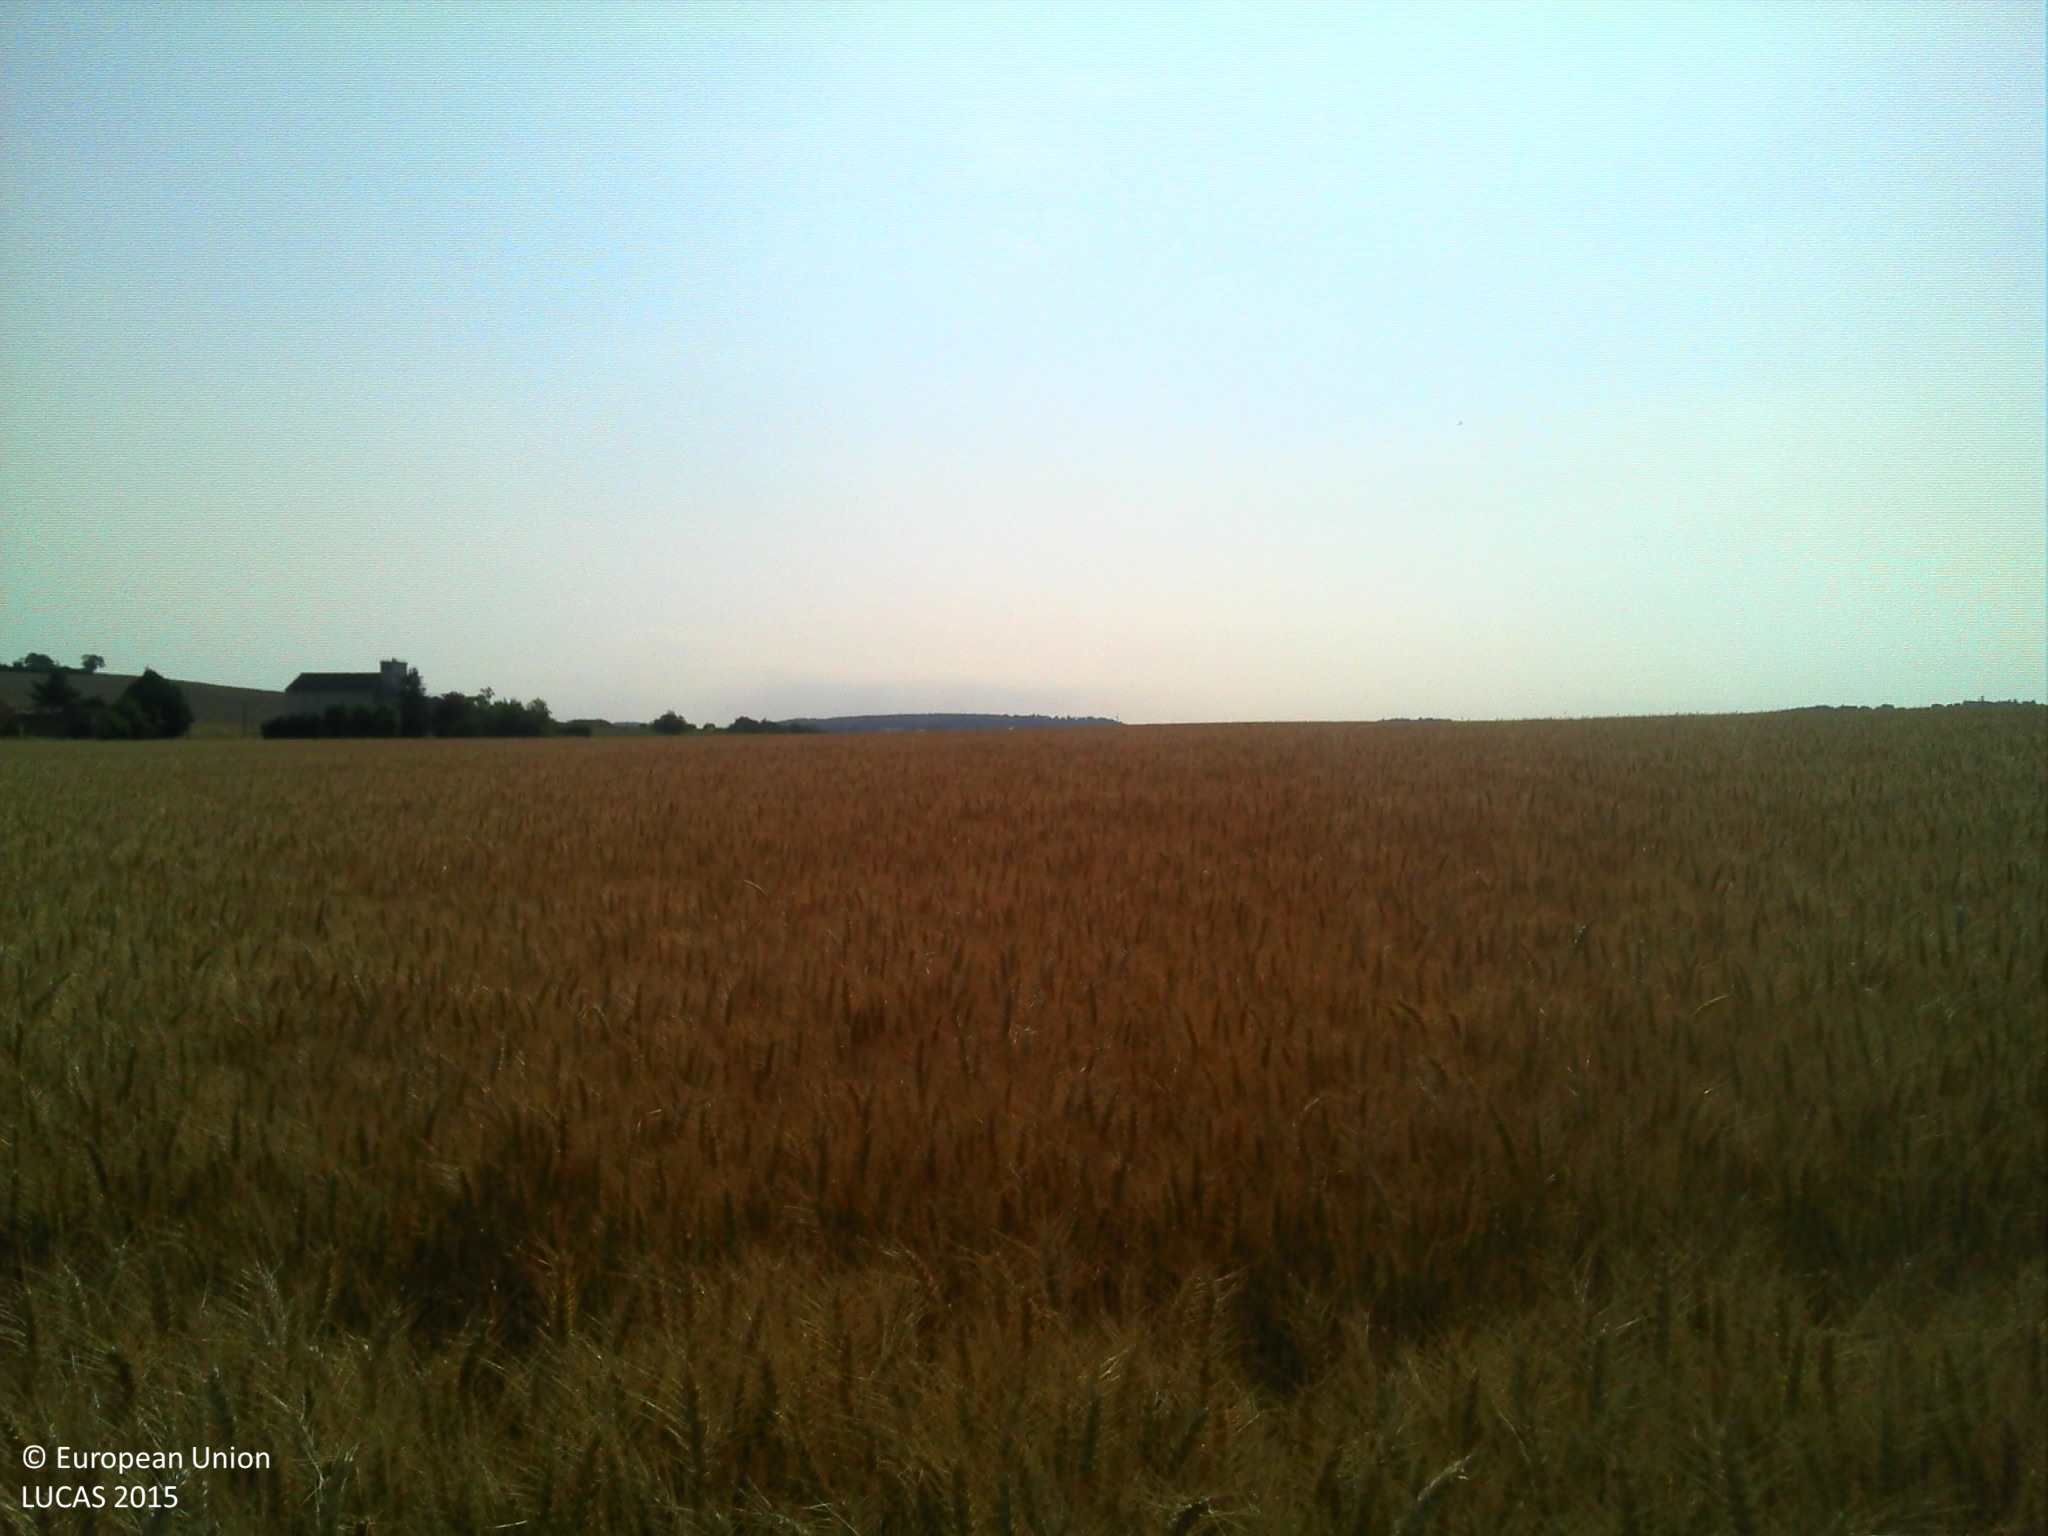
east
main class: Cropland
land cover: Common wheat
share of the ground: > 75 %
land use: Agriculture (excluding fallow land and kitchen gardens)
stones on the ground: < 10 %
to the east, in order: Common wheat
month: July
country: FR
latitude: 46.1462
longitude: 3.0980
